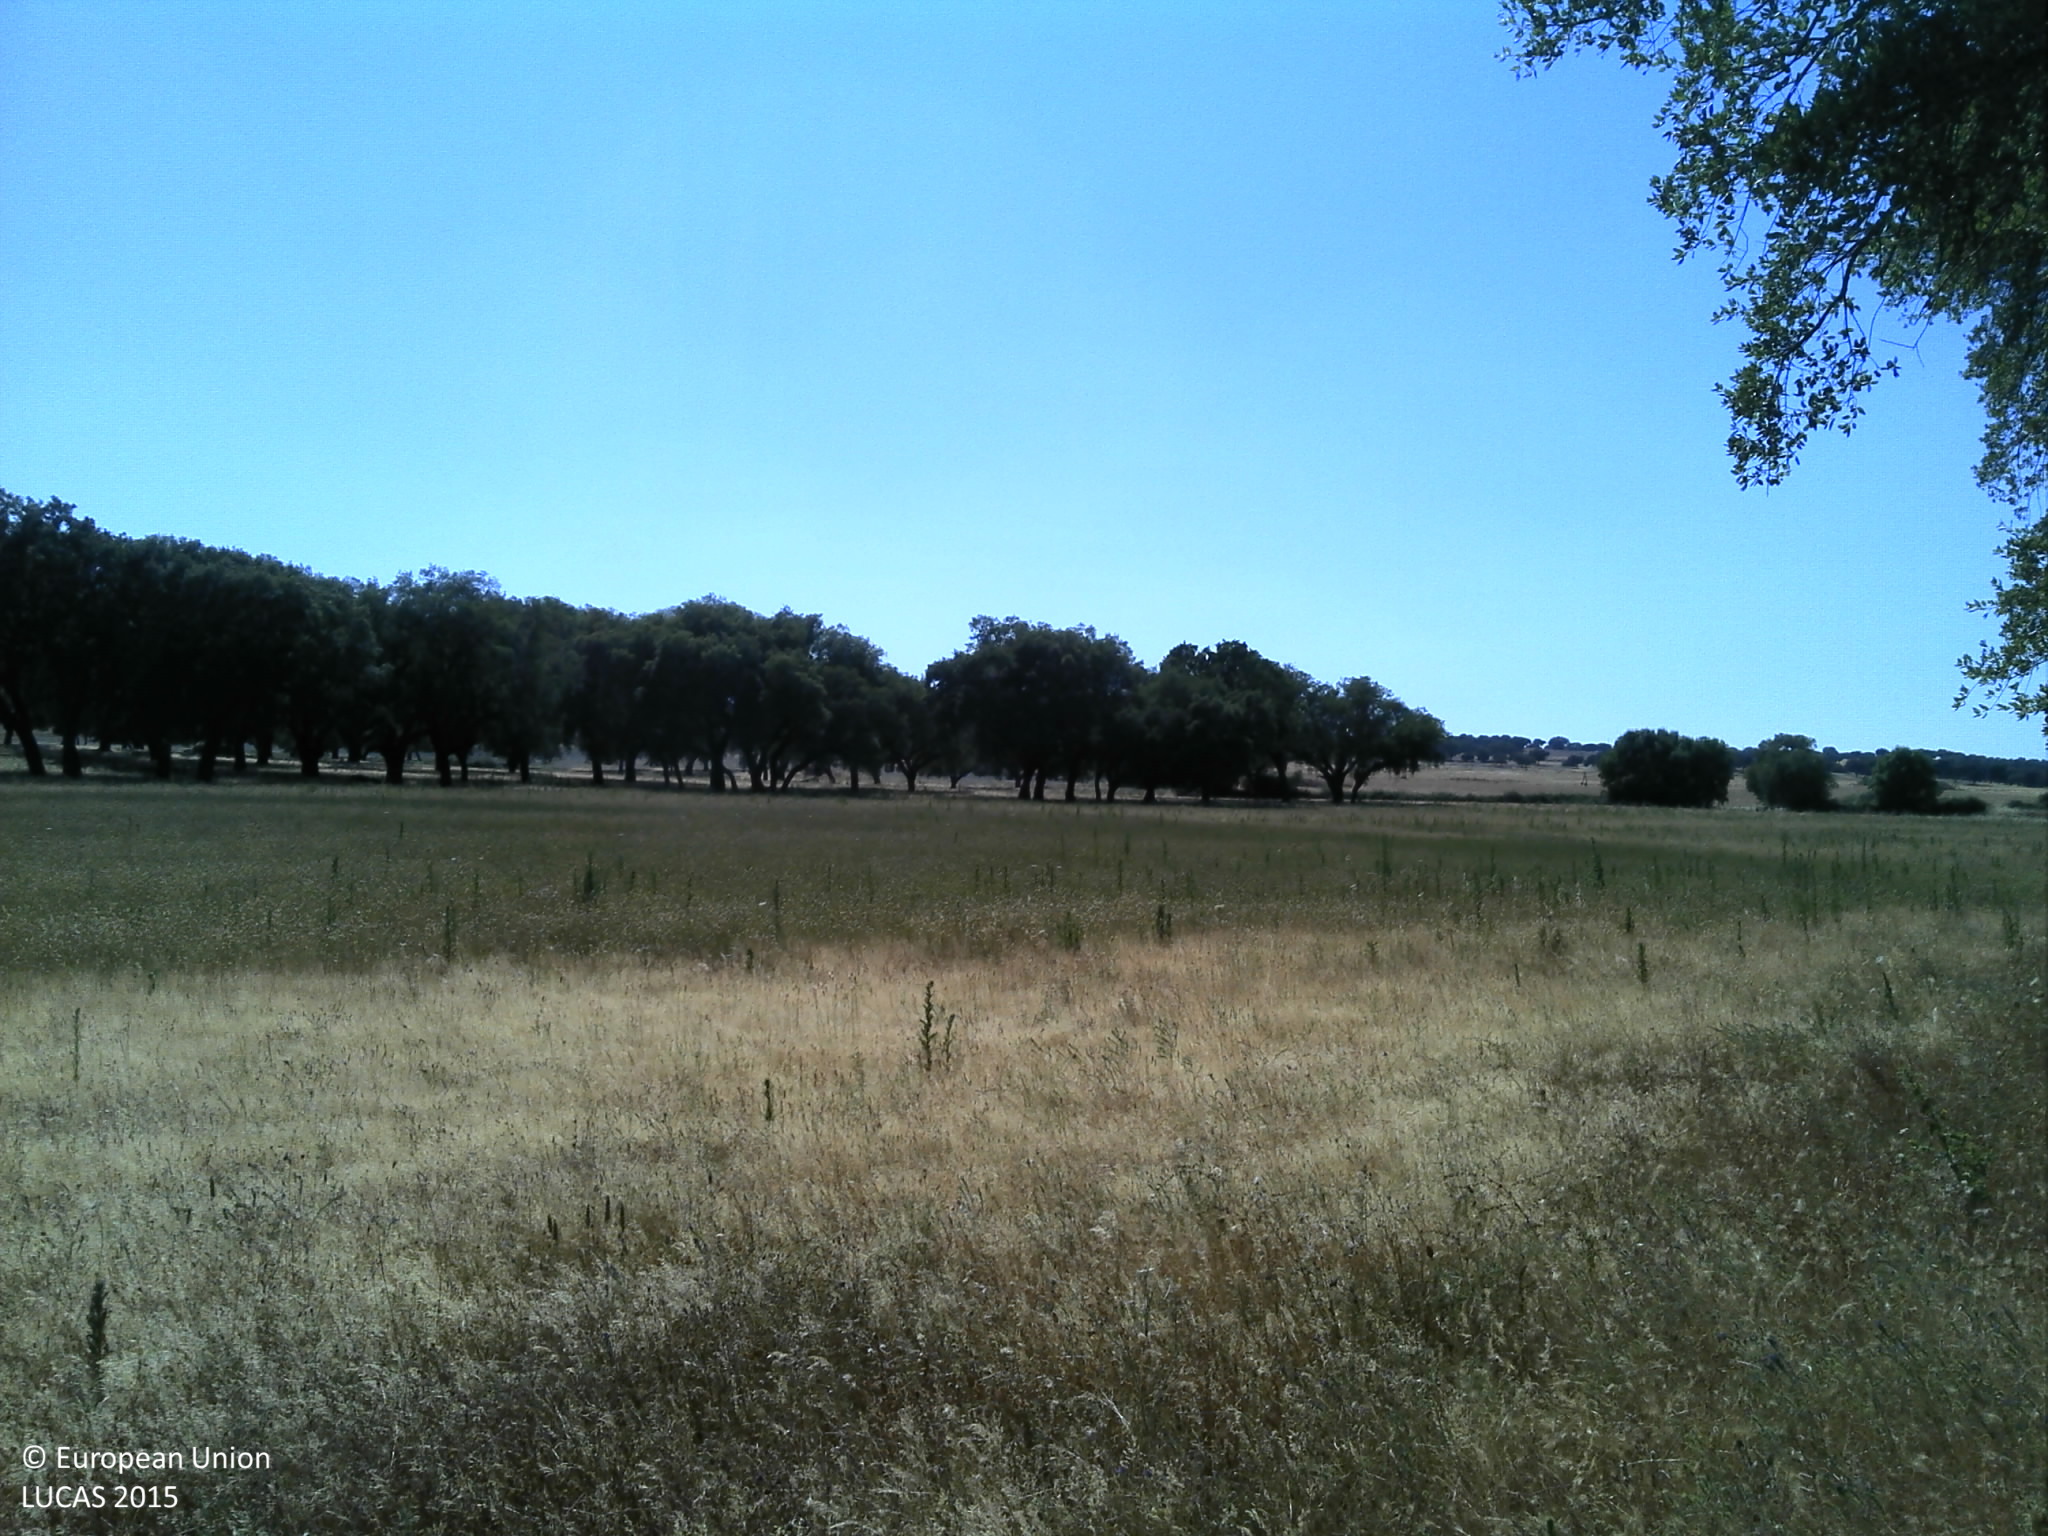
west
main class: Woodland
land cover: Broadleaved woodland
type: broadleaved evergreen forest
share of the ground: > 75 %
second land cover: Grassland without tree/shrub cover
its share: 50 - 75 %
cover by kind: broadleaved forest trees 75 %, herbaceous plants 25 %
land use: Forestry
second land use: Agriculture (excluding fallow land and kitchen gardens)
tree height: > 5 m
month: June
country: PT
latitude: 38.6827
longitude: -8.1767
